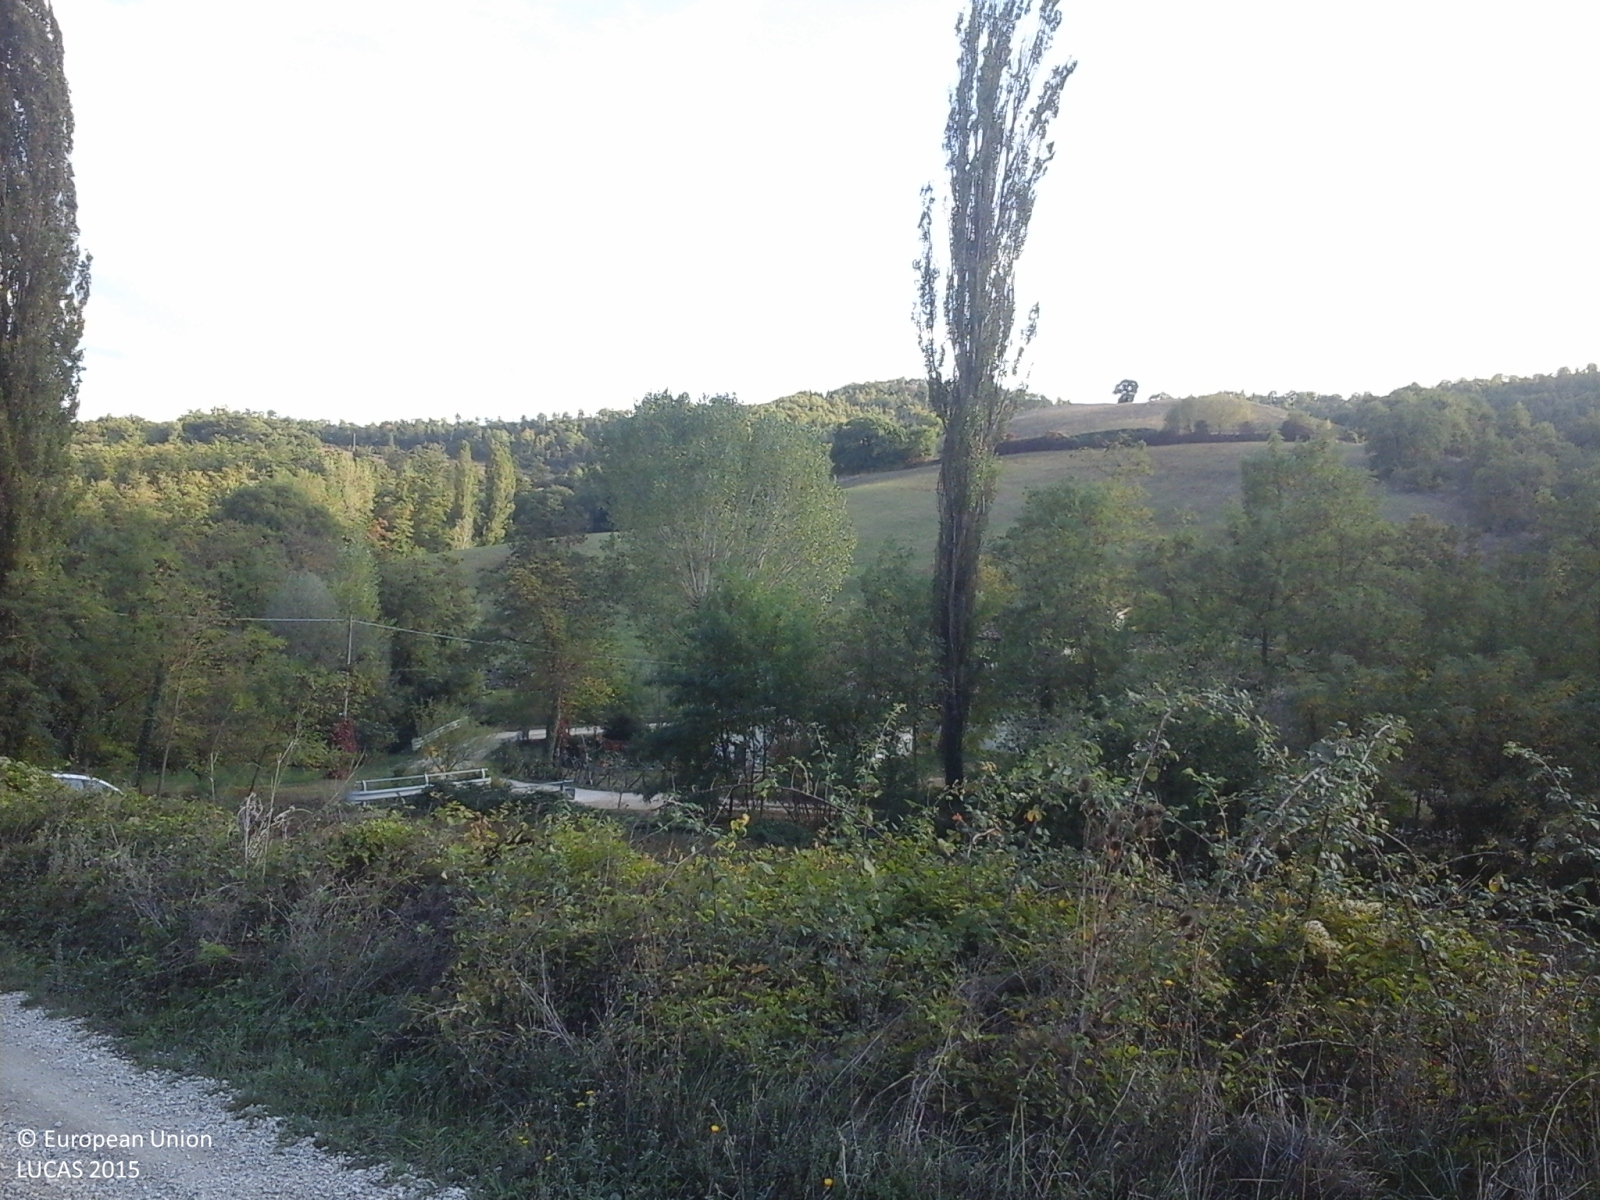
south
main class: Cropland
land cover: Olive groves
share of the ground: 25 - 50 %
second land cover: Grassland without tree/shrub cover
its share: > 75 %
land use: Agriculture (excluding fallow land and kitchen gardens)
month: October
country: IT
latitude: 43.2427
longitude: 12.2719
